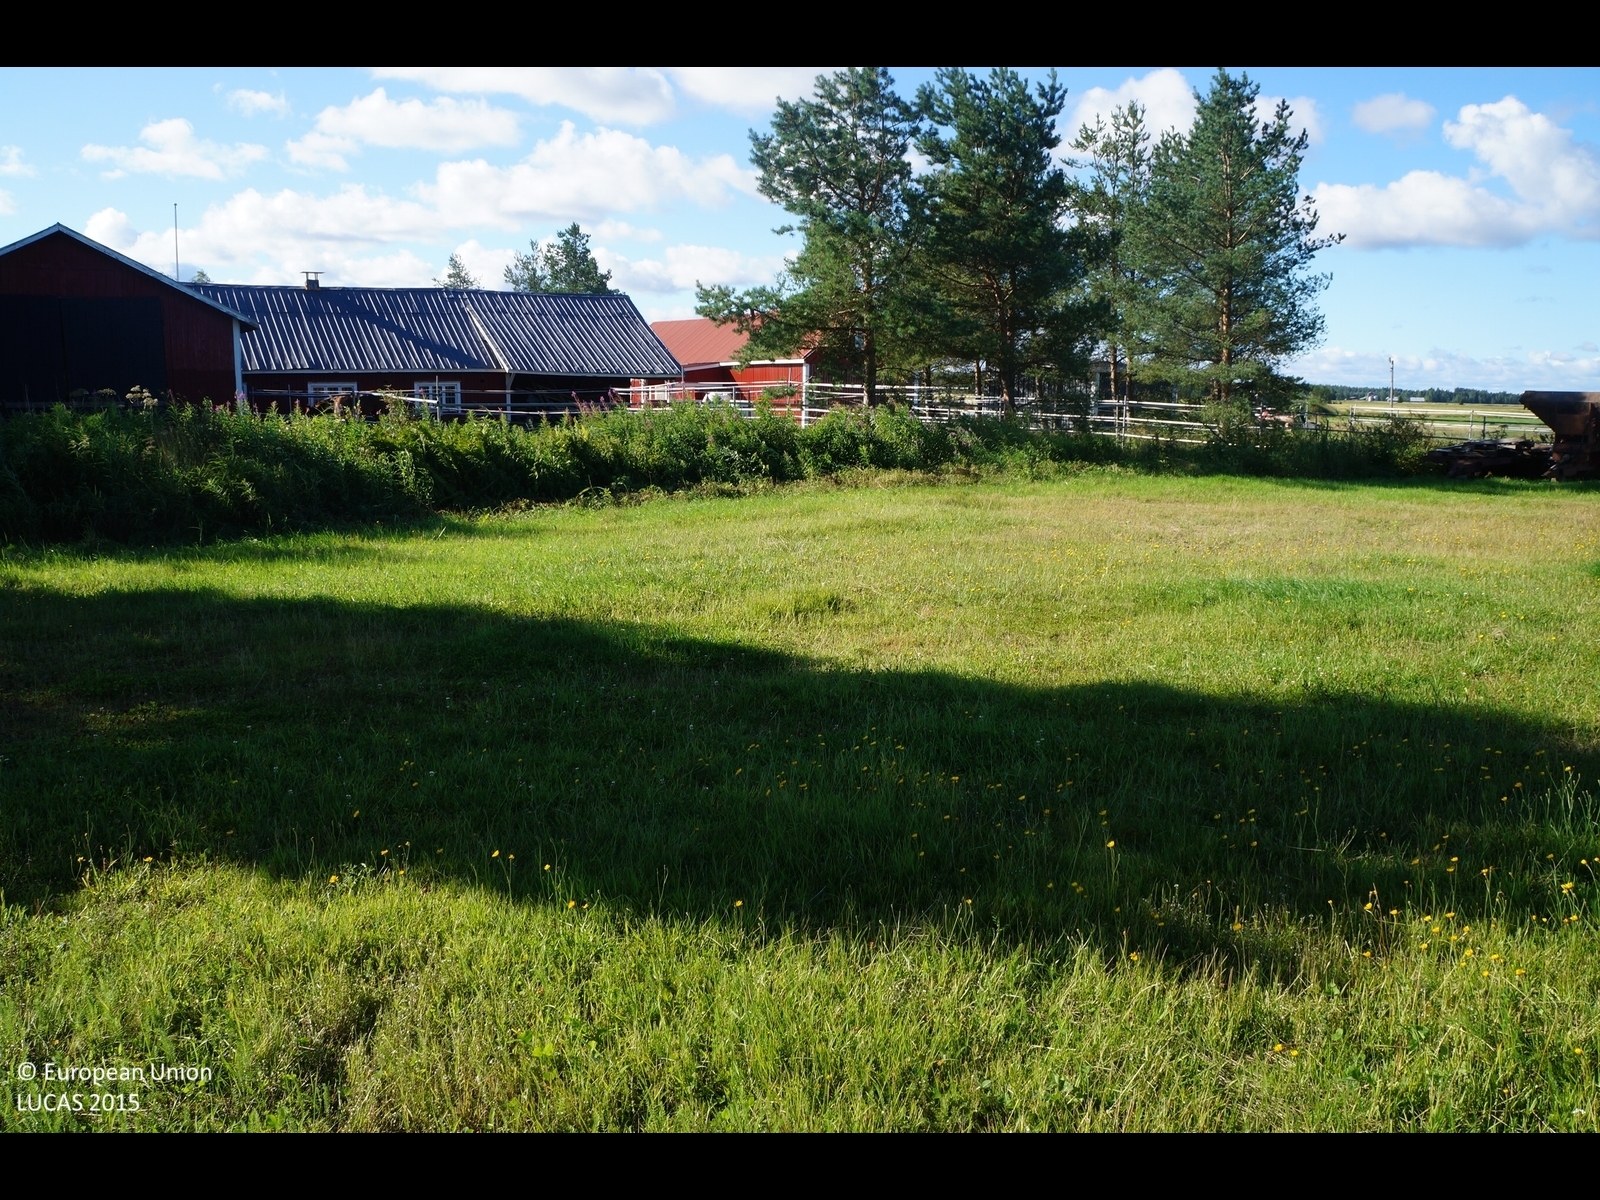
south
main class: Grassland
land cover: Grassland with sparse tree/shrub cover
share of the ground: > 75 %
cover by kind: herbaceous plants 90 %, coniferous forest trees 5 %, shrubs 5 %
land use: Agriculture (excluding fallow land and kitchen gardens)
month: August
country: FI
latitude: 64.7975
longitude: 25.4714
